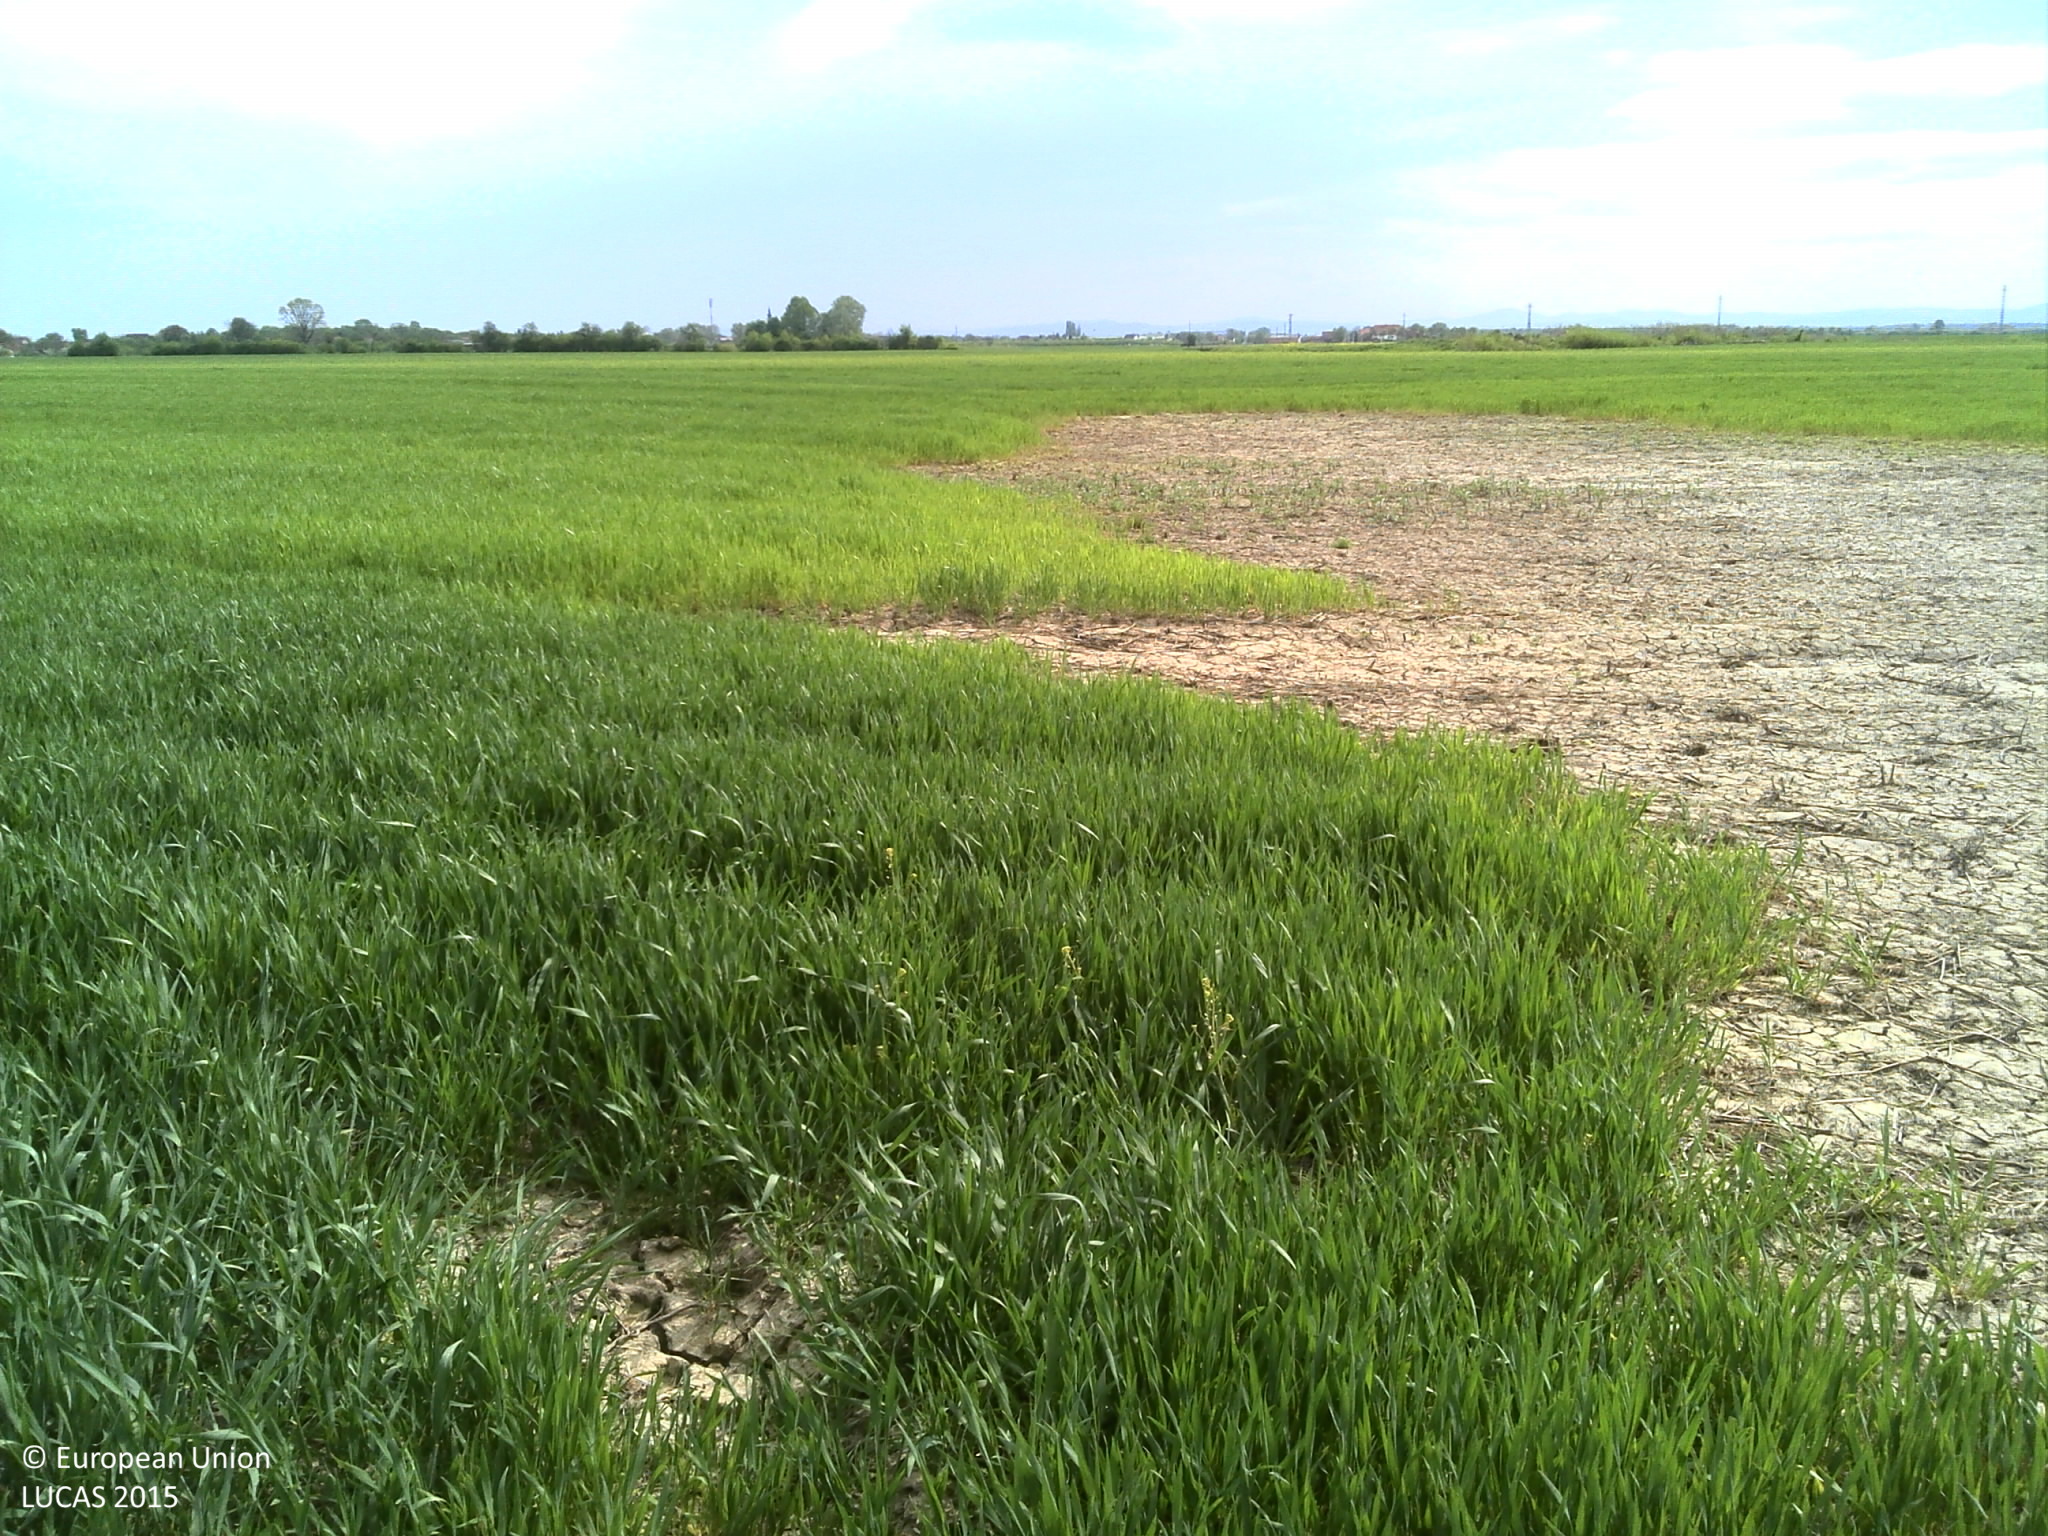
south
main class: Cropland
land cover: Common wheat
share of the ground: > 75 %
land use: Agriculture (excluding fallow land and kitchen gardens)
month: April
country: HR
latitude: 44.9989
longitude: 18.9246
